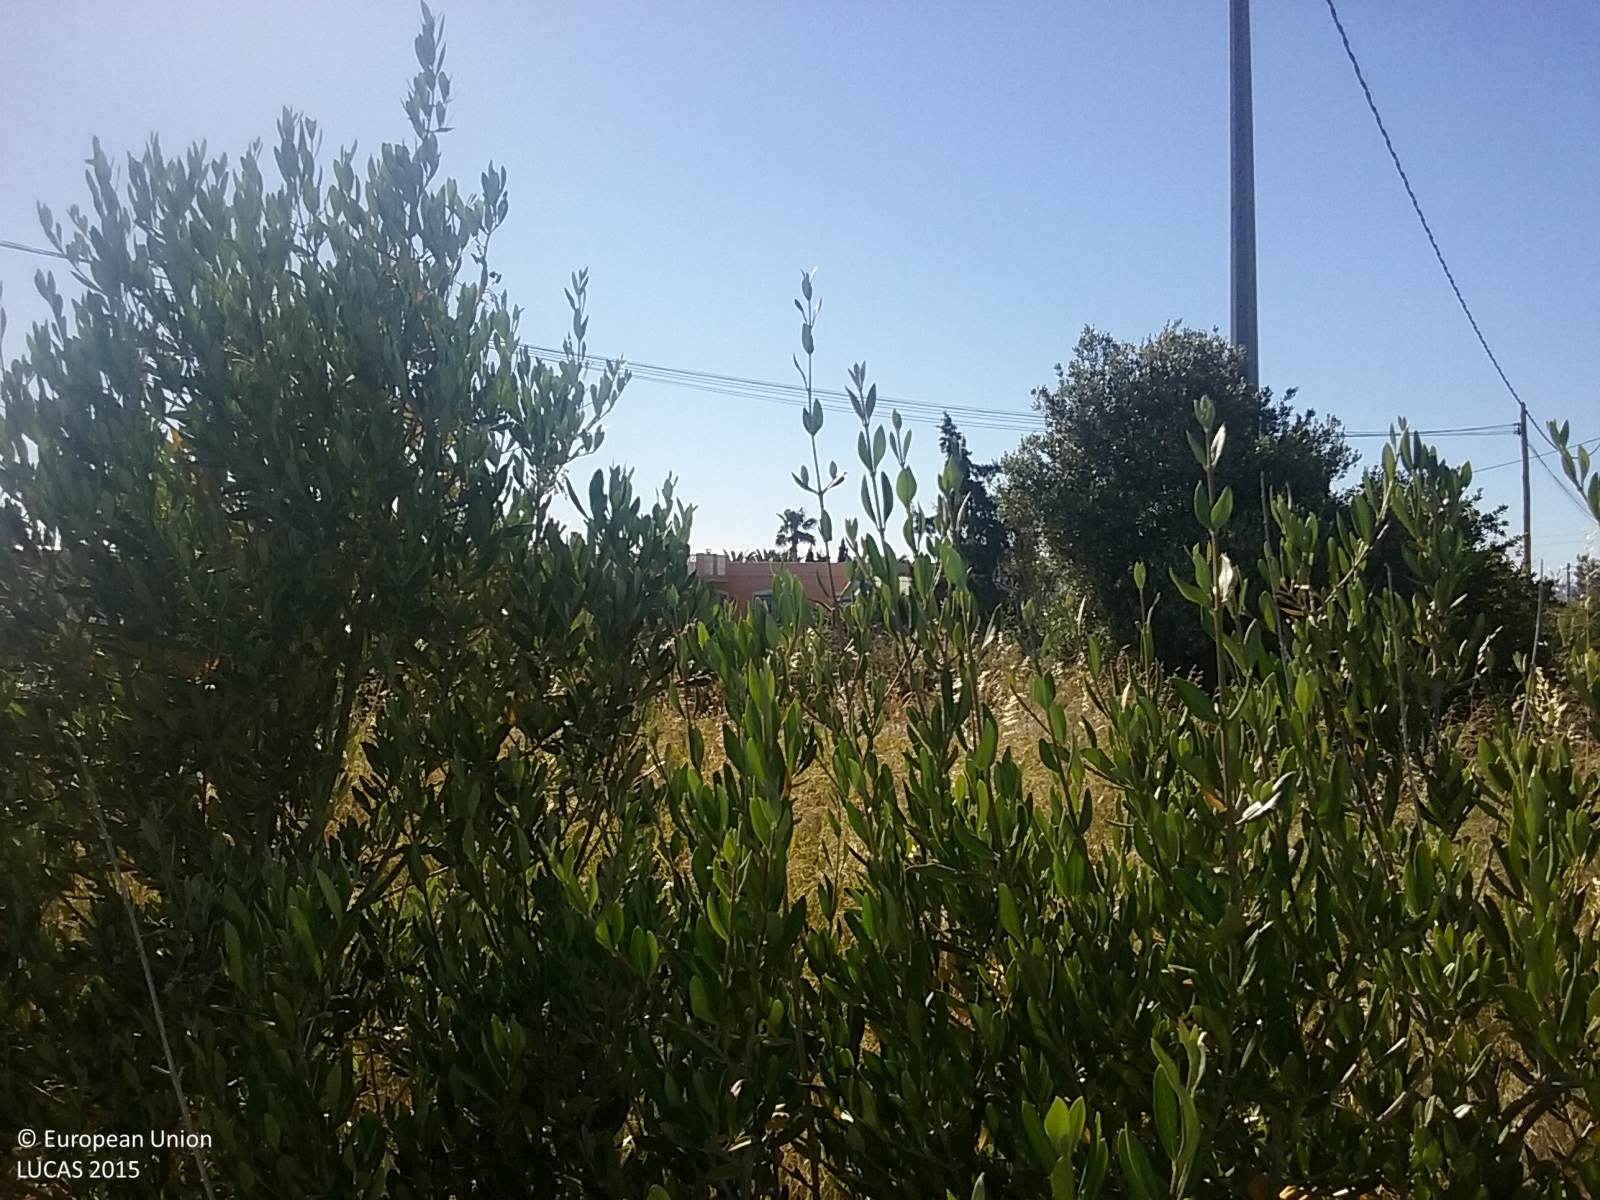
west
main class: Cropland
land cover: Olive groves
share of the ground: 50 - 75 %
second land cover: Grassland without tree/shrub cover
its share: 50 - 75 %
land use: Abandoned areas
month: May
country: ES
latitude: 40.2183
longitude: 0.2567
